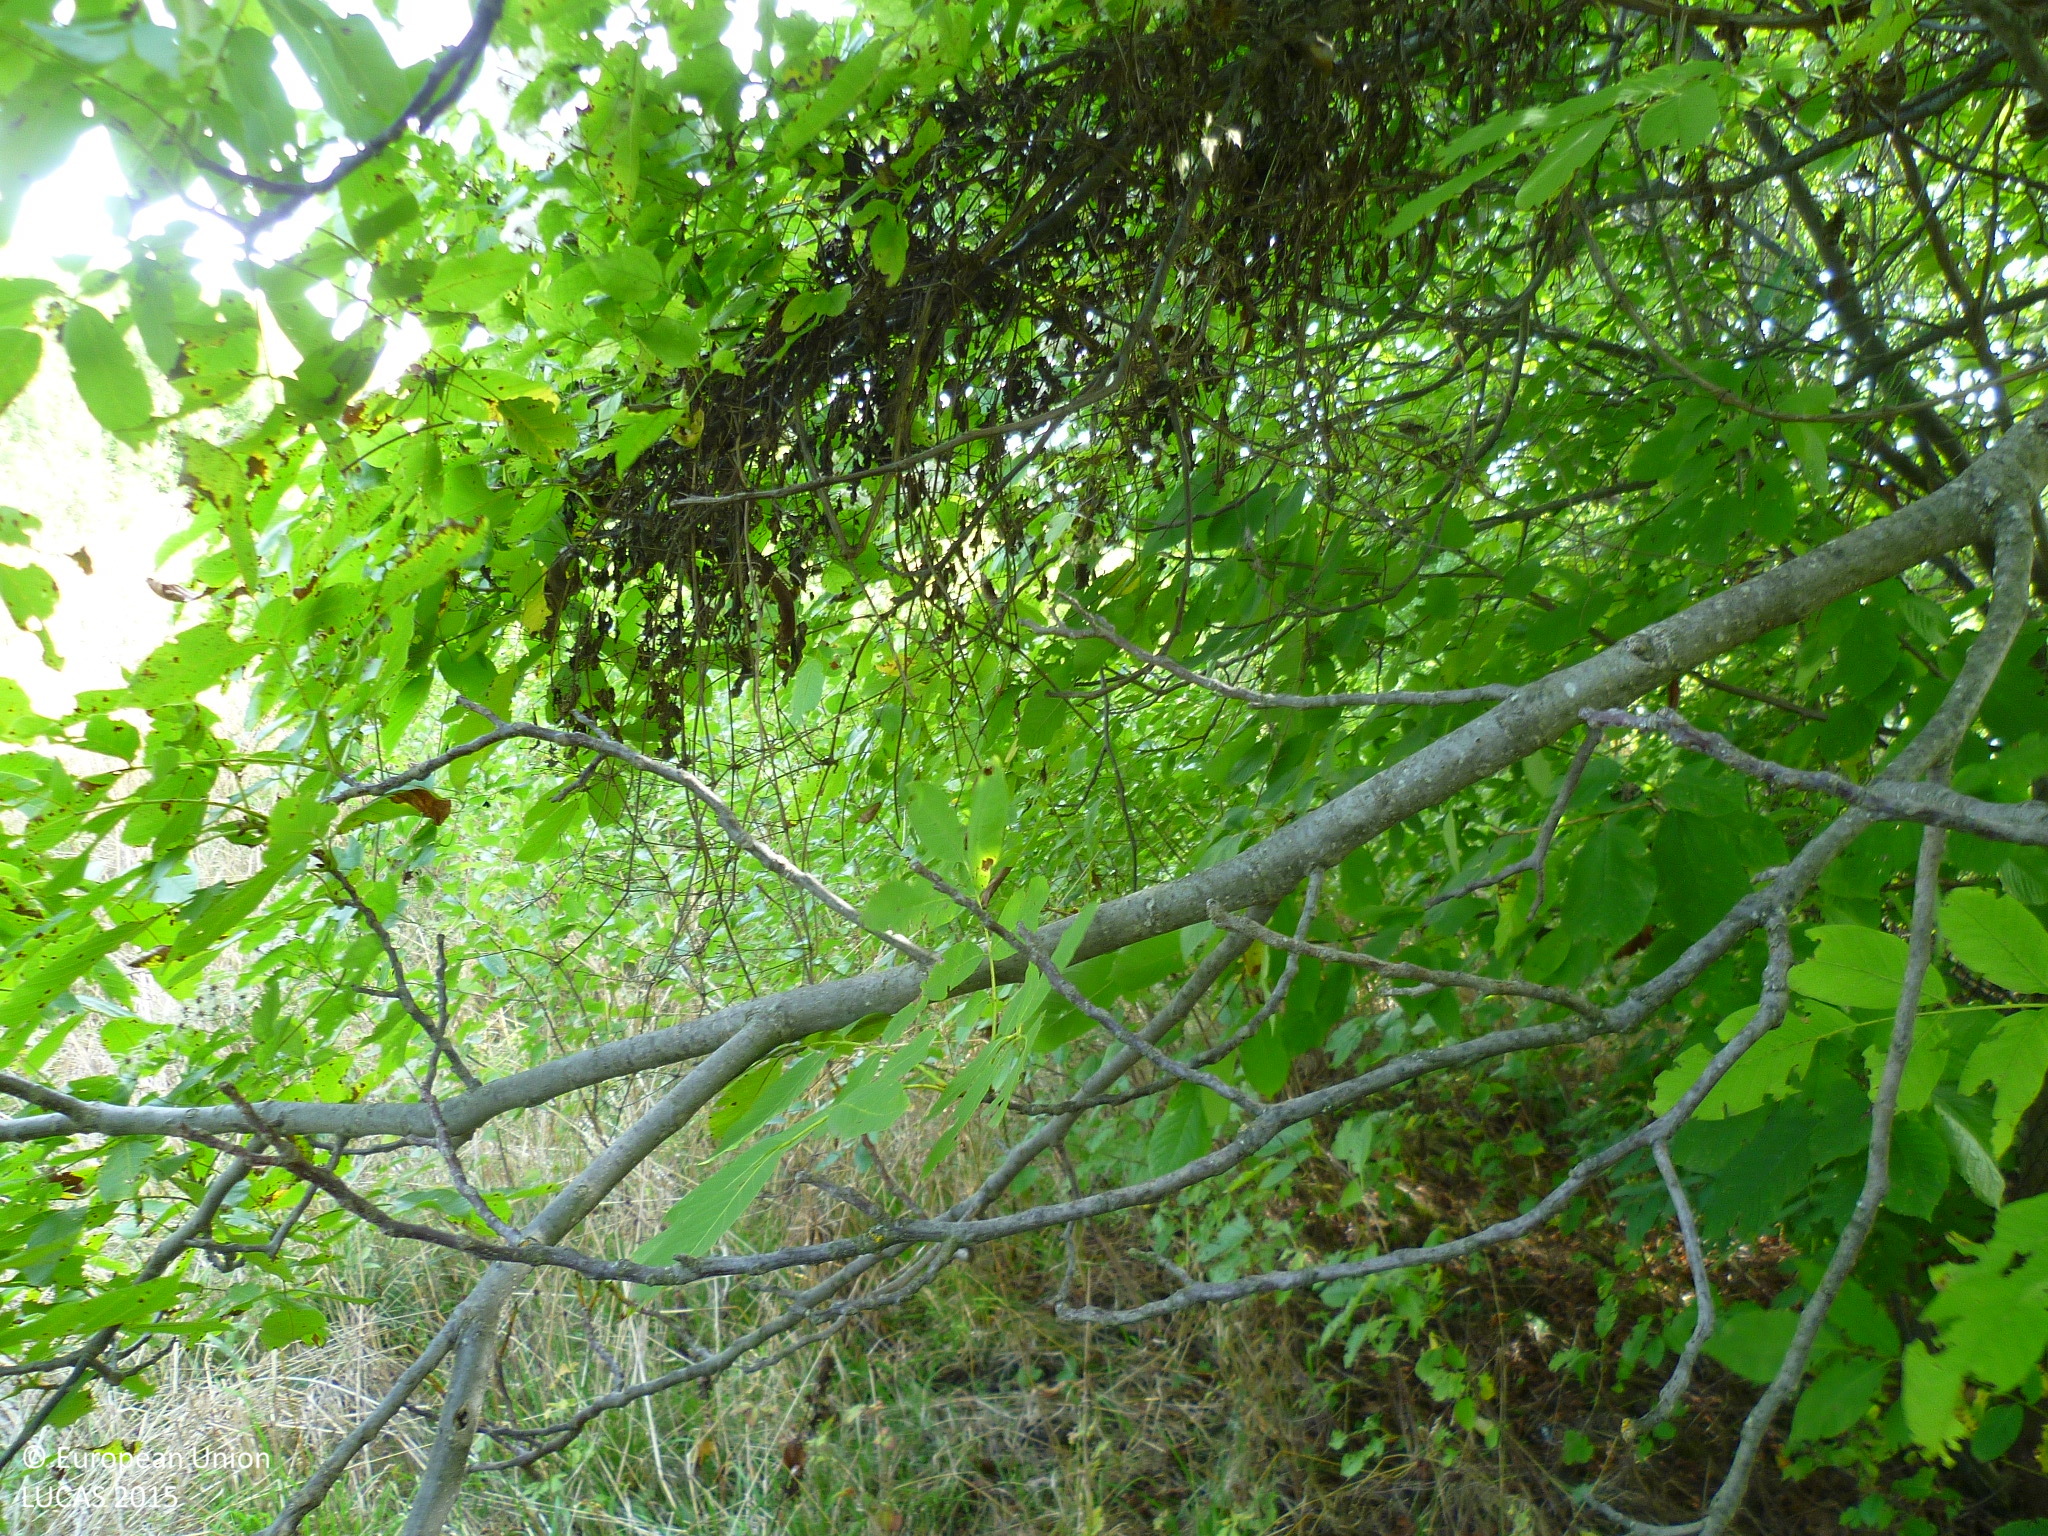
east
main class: Cropland
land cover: Nuts trees
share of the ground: 25 - 50 %
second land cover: Spontaneously vegetated surfaces
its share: 50 - 75 %
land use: Kitchen garden
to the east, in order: Nuts trees; Spontaneously vegetated surfaces; Fences; Tracks; Fences; Other bare soil; Fences; Grassland with sparse tree/shrub cover; Shrubland without tree cover; Broadleaved woodland; Grassland with sparse tree/shrub cover; Shrubland without tree cover; Grassland with sparse tree/shrub cover
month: October
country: BG
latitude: 42.8376
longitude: 22.8385
